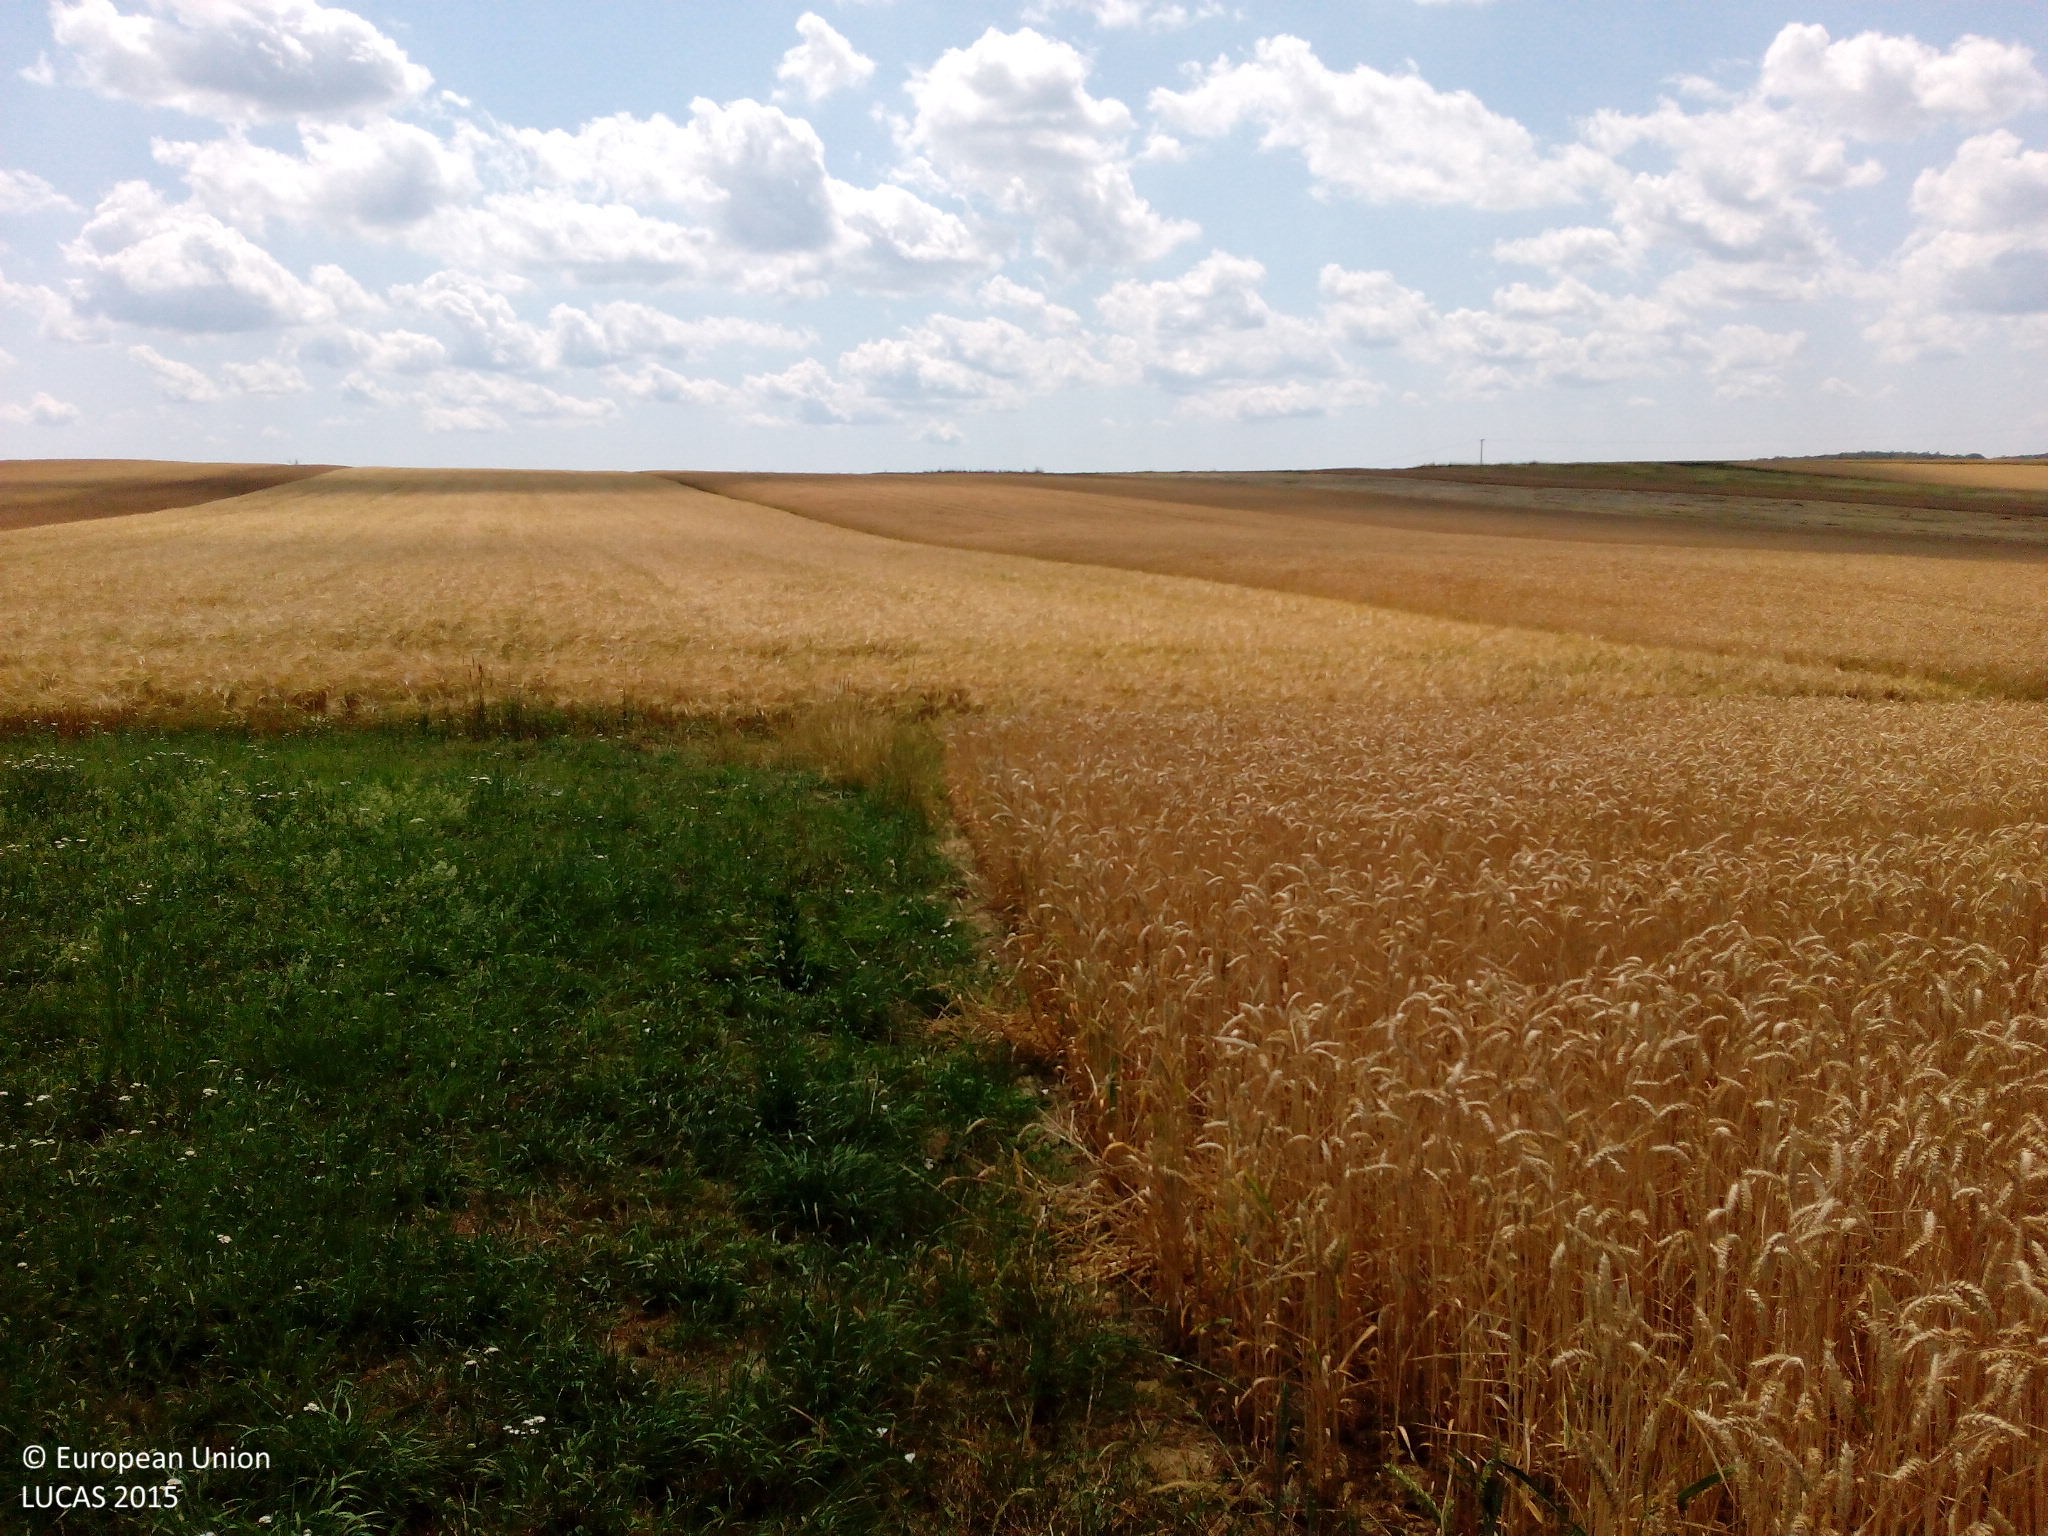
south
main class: Grassland
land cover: Grassland without tree/shrub cover
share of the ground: > 75 %
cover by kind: herbaceous plants 90 %, unconsolidated bare surface 10 %
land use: Agriculture (excluding fallow land and kitchen gardens)
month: July
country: DE
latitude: 49.2401
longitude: 7.5419
